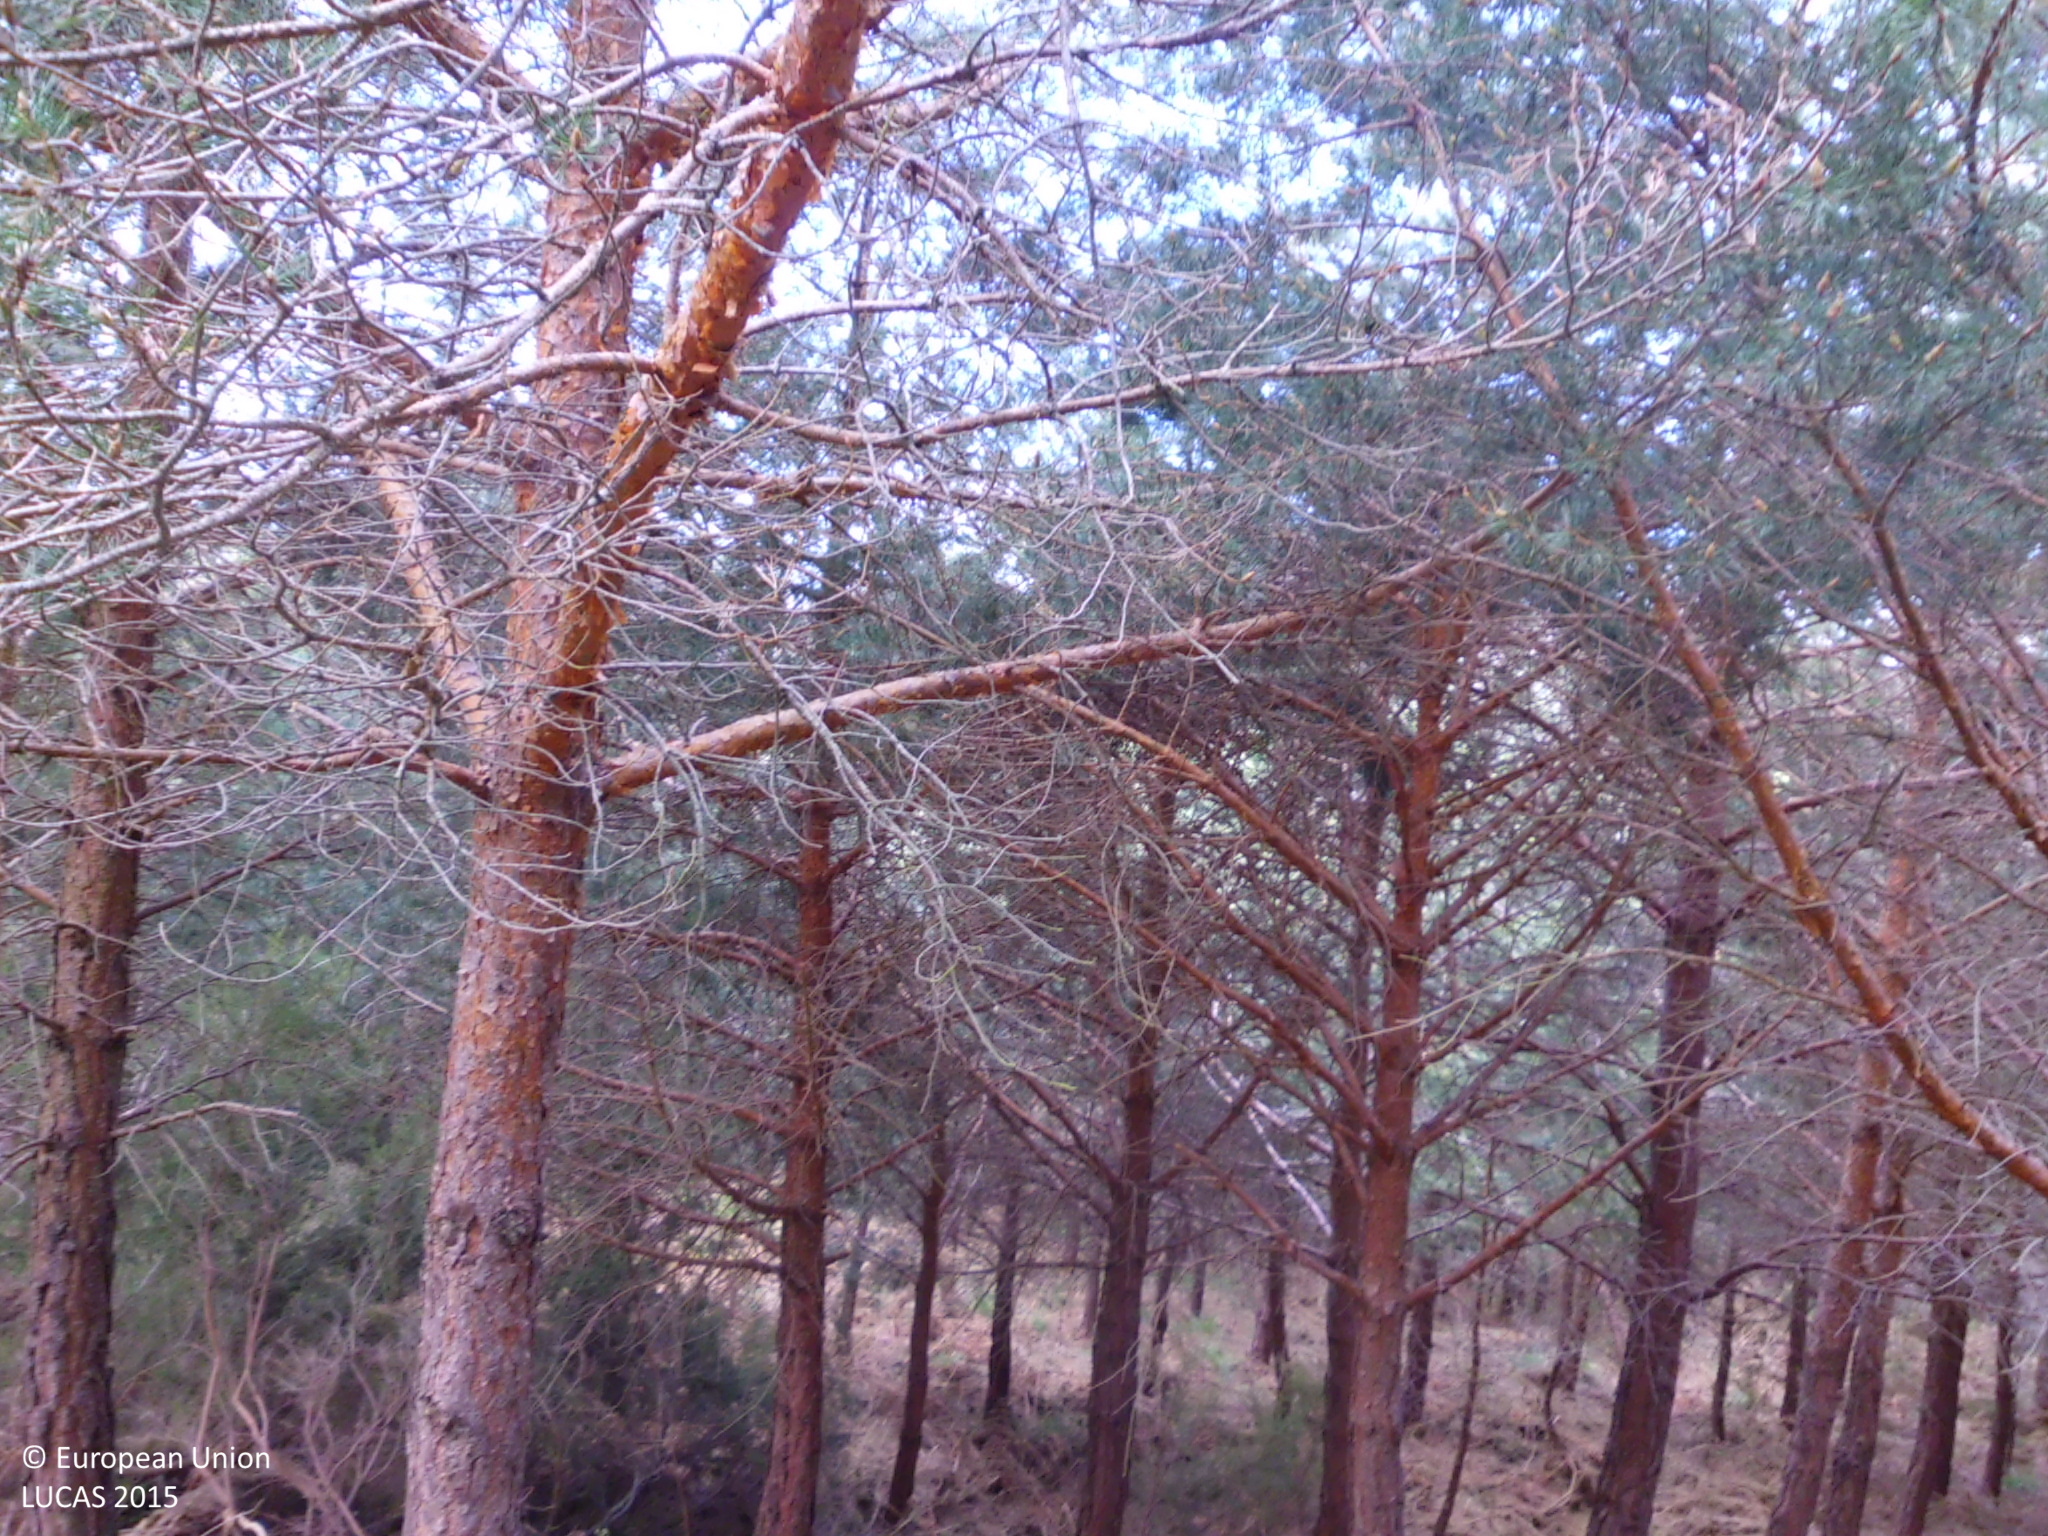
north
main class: Woodland
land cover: Pine dominated coniferous woodland
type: coniferous forest of the mediterranean region
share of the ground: > 75 %
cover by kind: coniferous forest trees 100 %
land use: Semi-natural and natural areas not in use
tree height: > 5 m
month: May
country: ES
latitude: 42.8839
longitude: -3.8676
